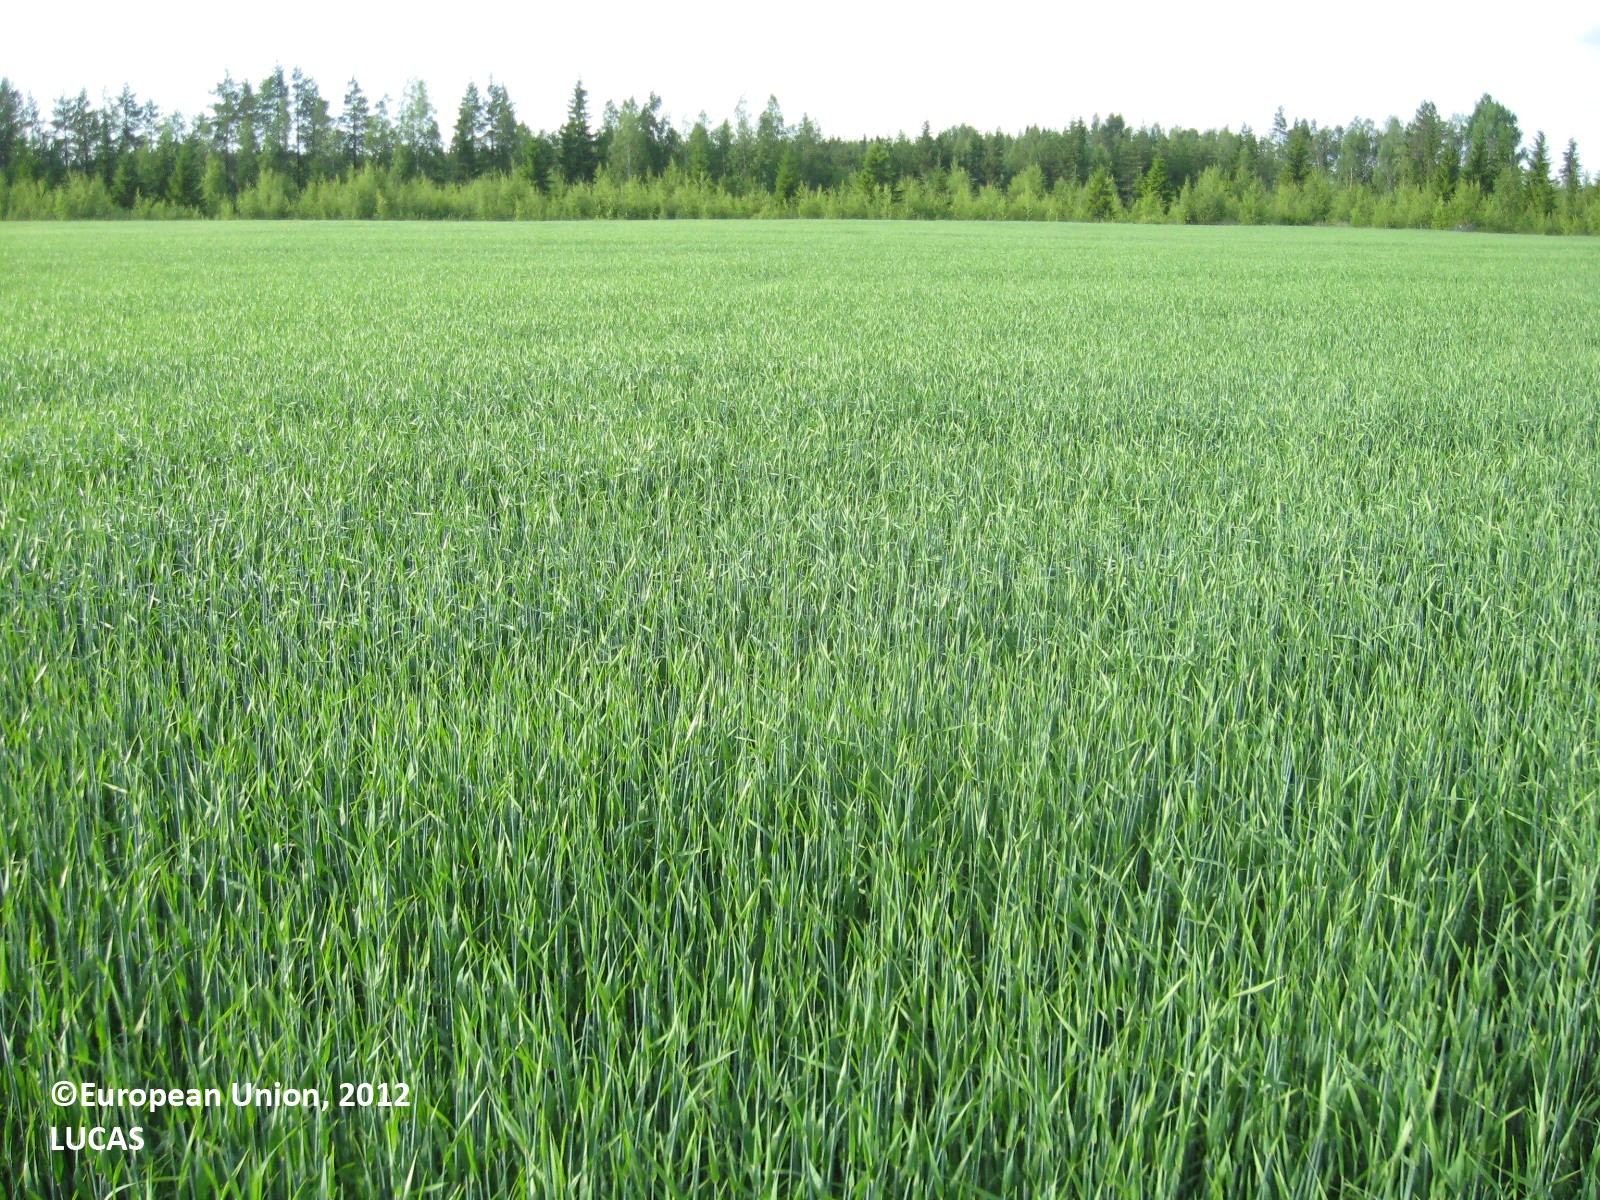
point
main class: Cropland
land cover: Barley
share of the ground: > 75 %
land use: Agriculture (excluding fallow land and kitchen gardens)
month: July
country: FI
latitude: 62.5183
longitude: 21.7198
